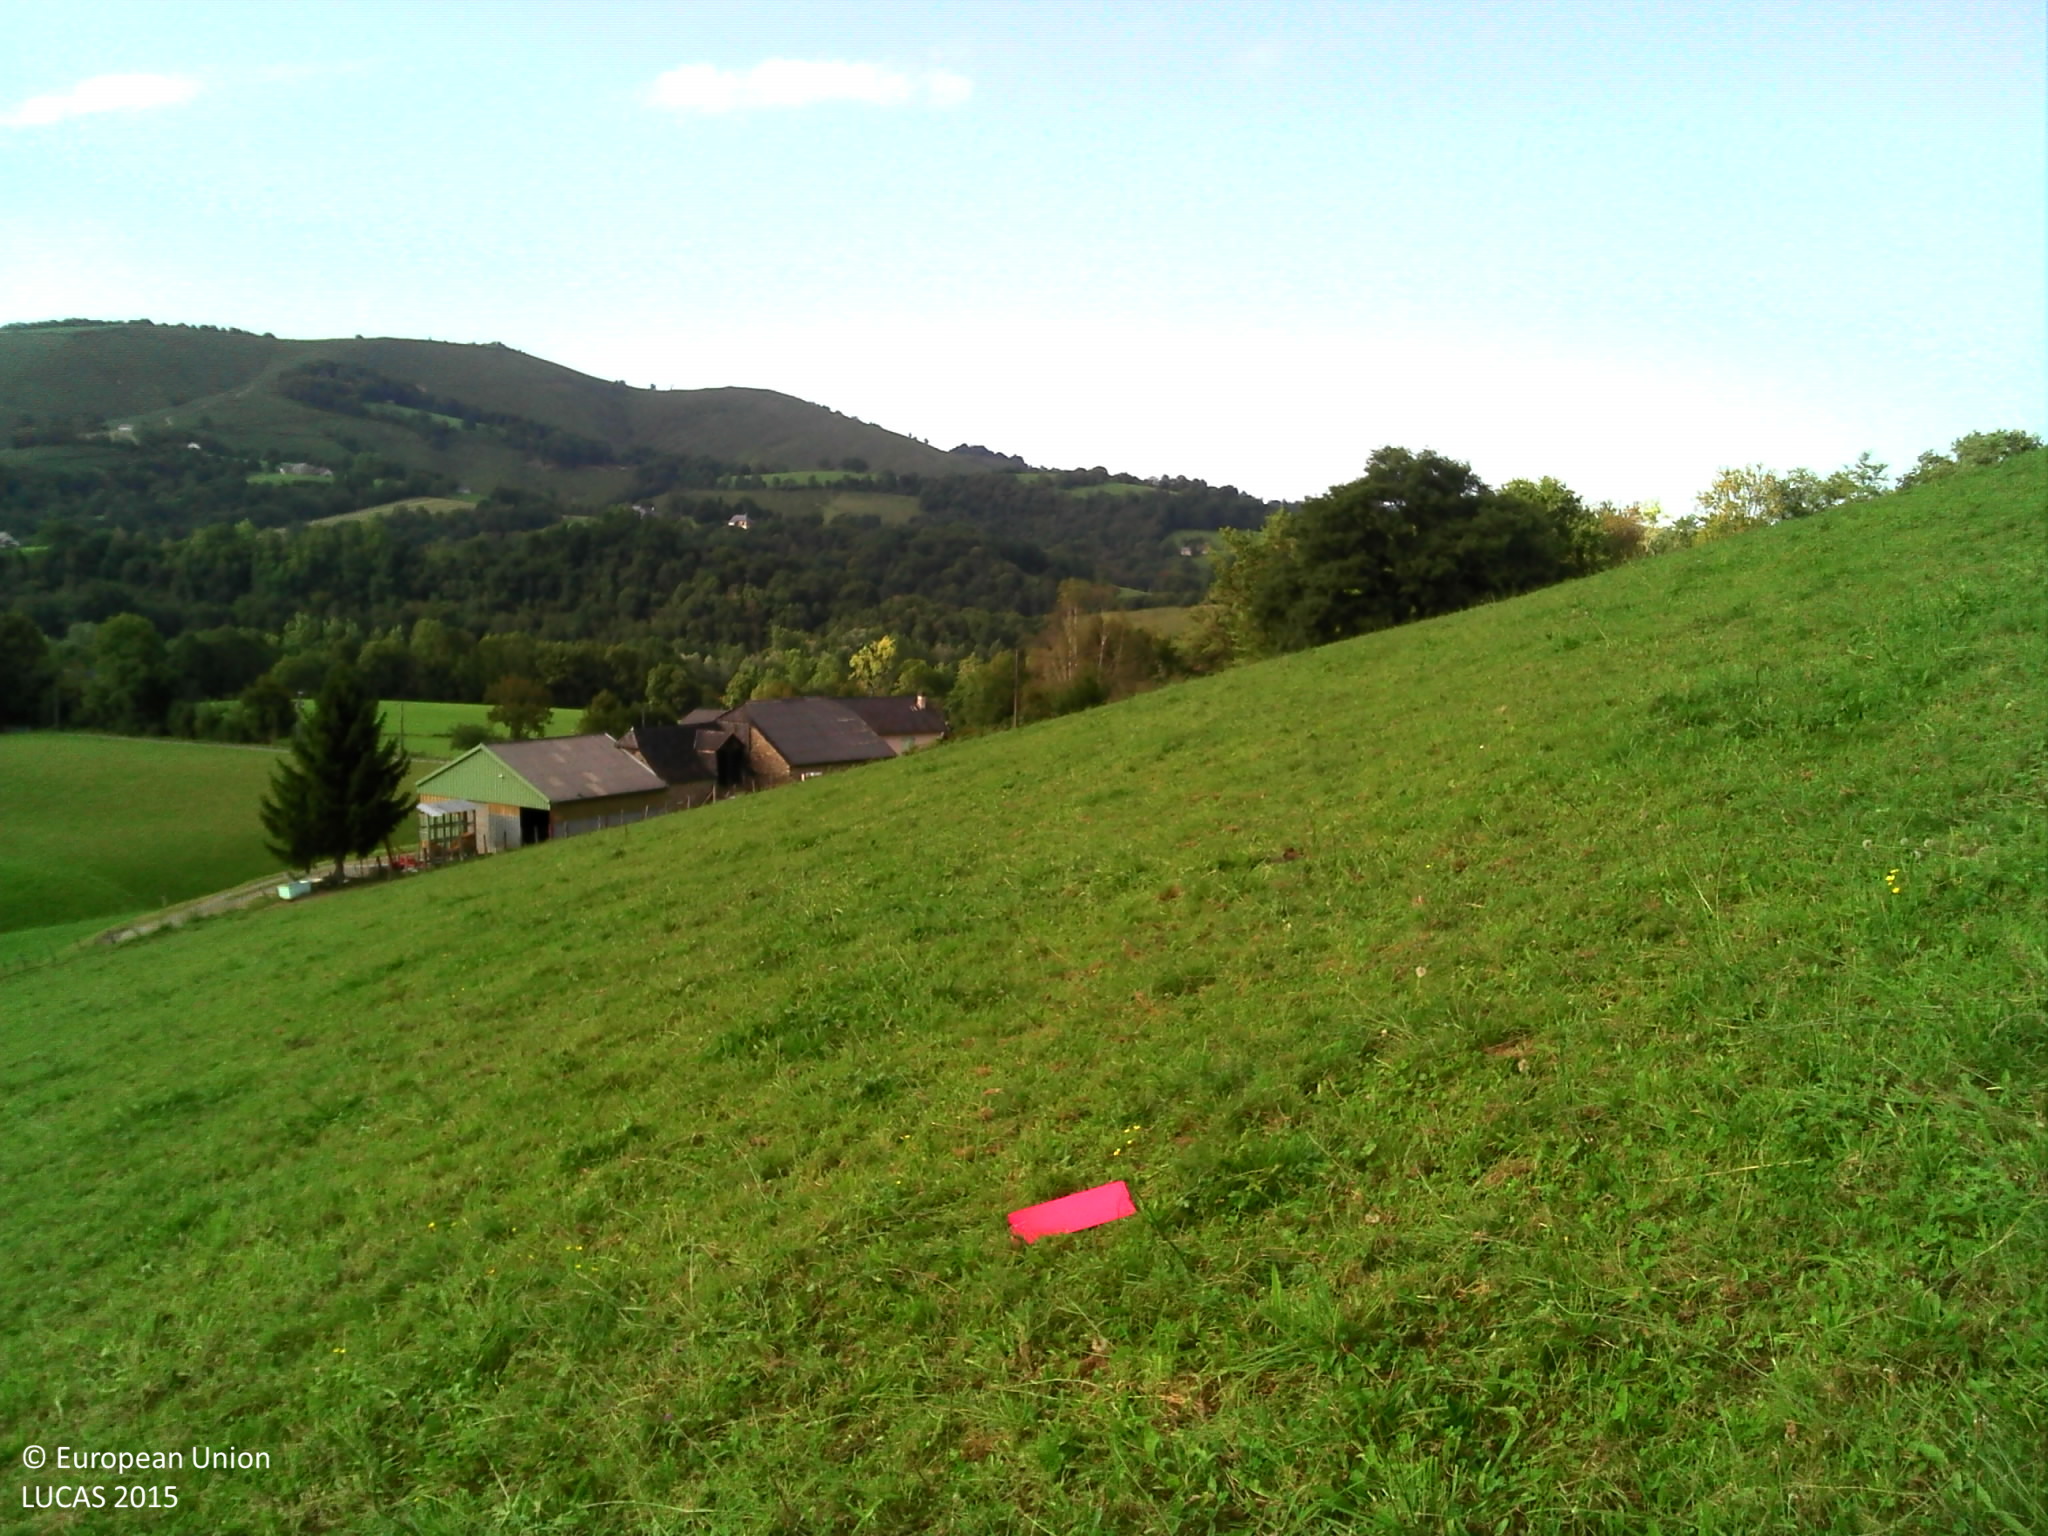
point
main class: Grassland
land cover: Grassland without tree/shrub cover
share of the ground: > 75 %
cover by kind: herbaceous plants 100 %
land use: Agriculture (excluding fallow land and kitchen gardens)
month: September
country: FR
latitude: 43.1214
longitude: -0.7137
